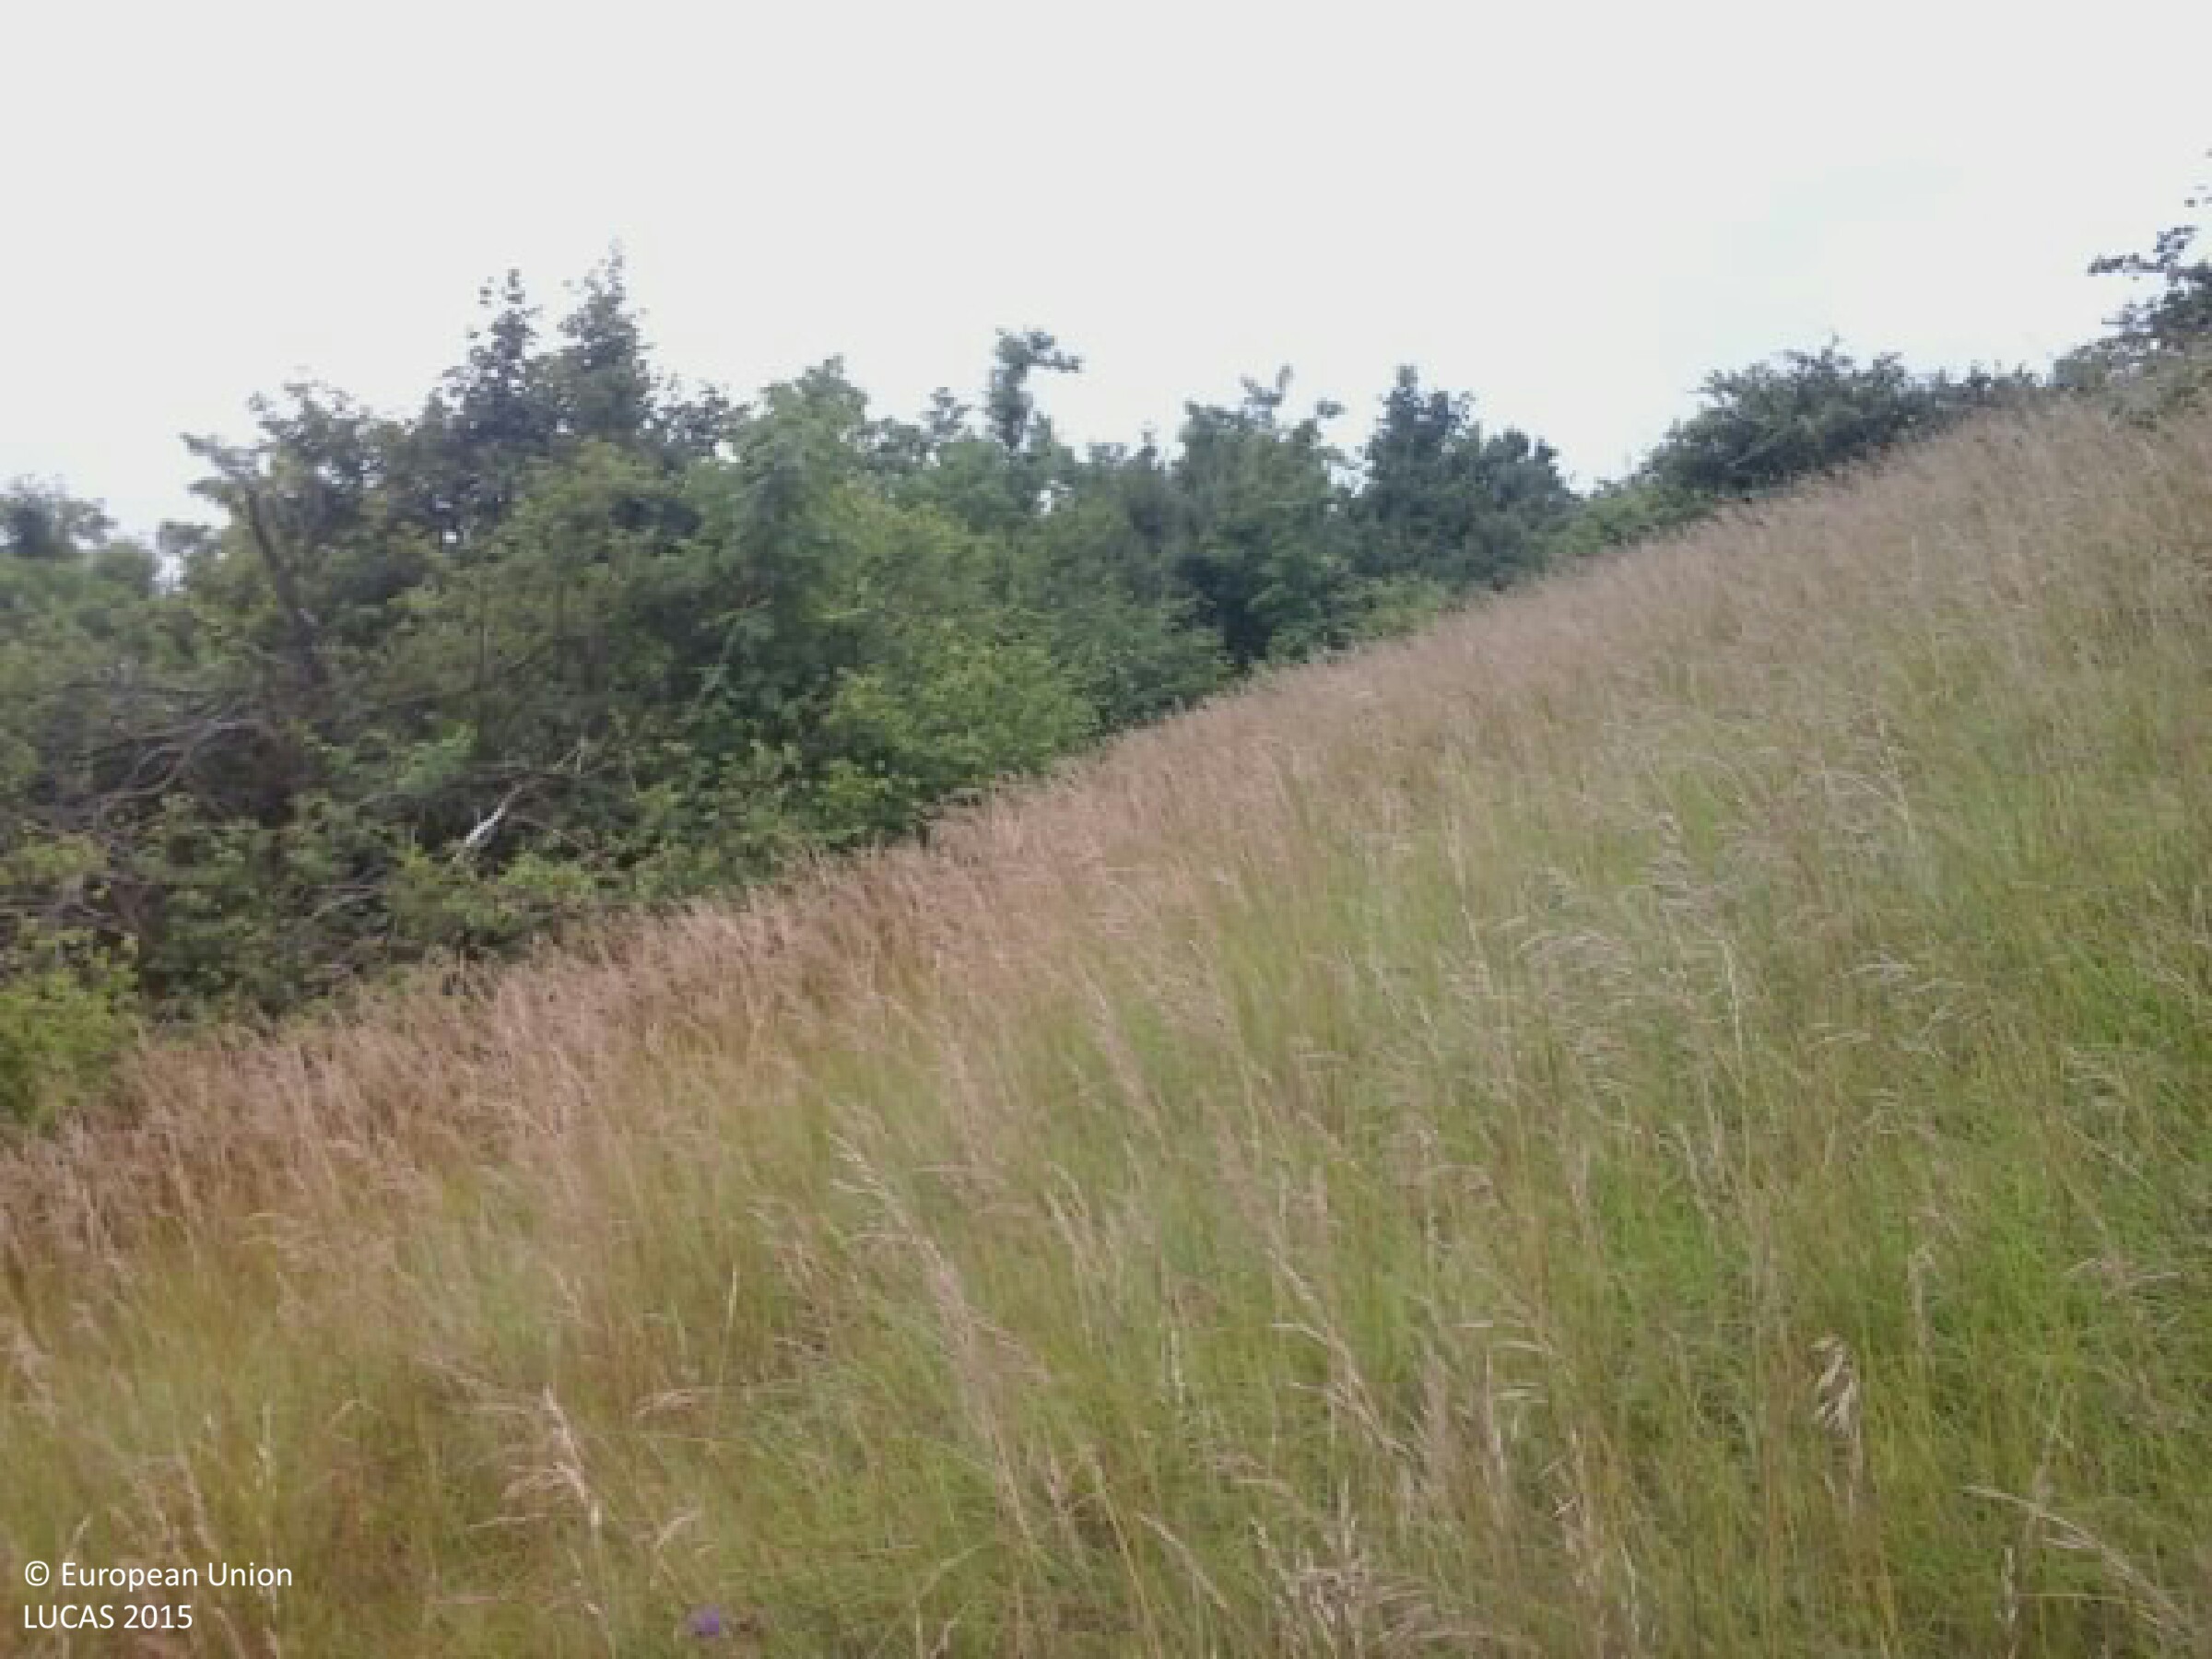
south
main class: Woodland
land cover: Broadleaved woodland
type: mesophytic deciduous forest
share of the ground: 25 - 50 %
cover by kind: herbaceous plants 50 %, broadleaved forest trees 40 %, shrubs 10 %
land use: Semi-natural and natural areas not in use
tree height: > 5 m
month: June
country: HU
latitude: 47.4767
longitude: 19.4020
